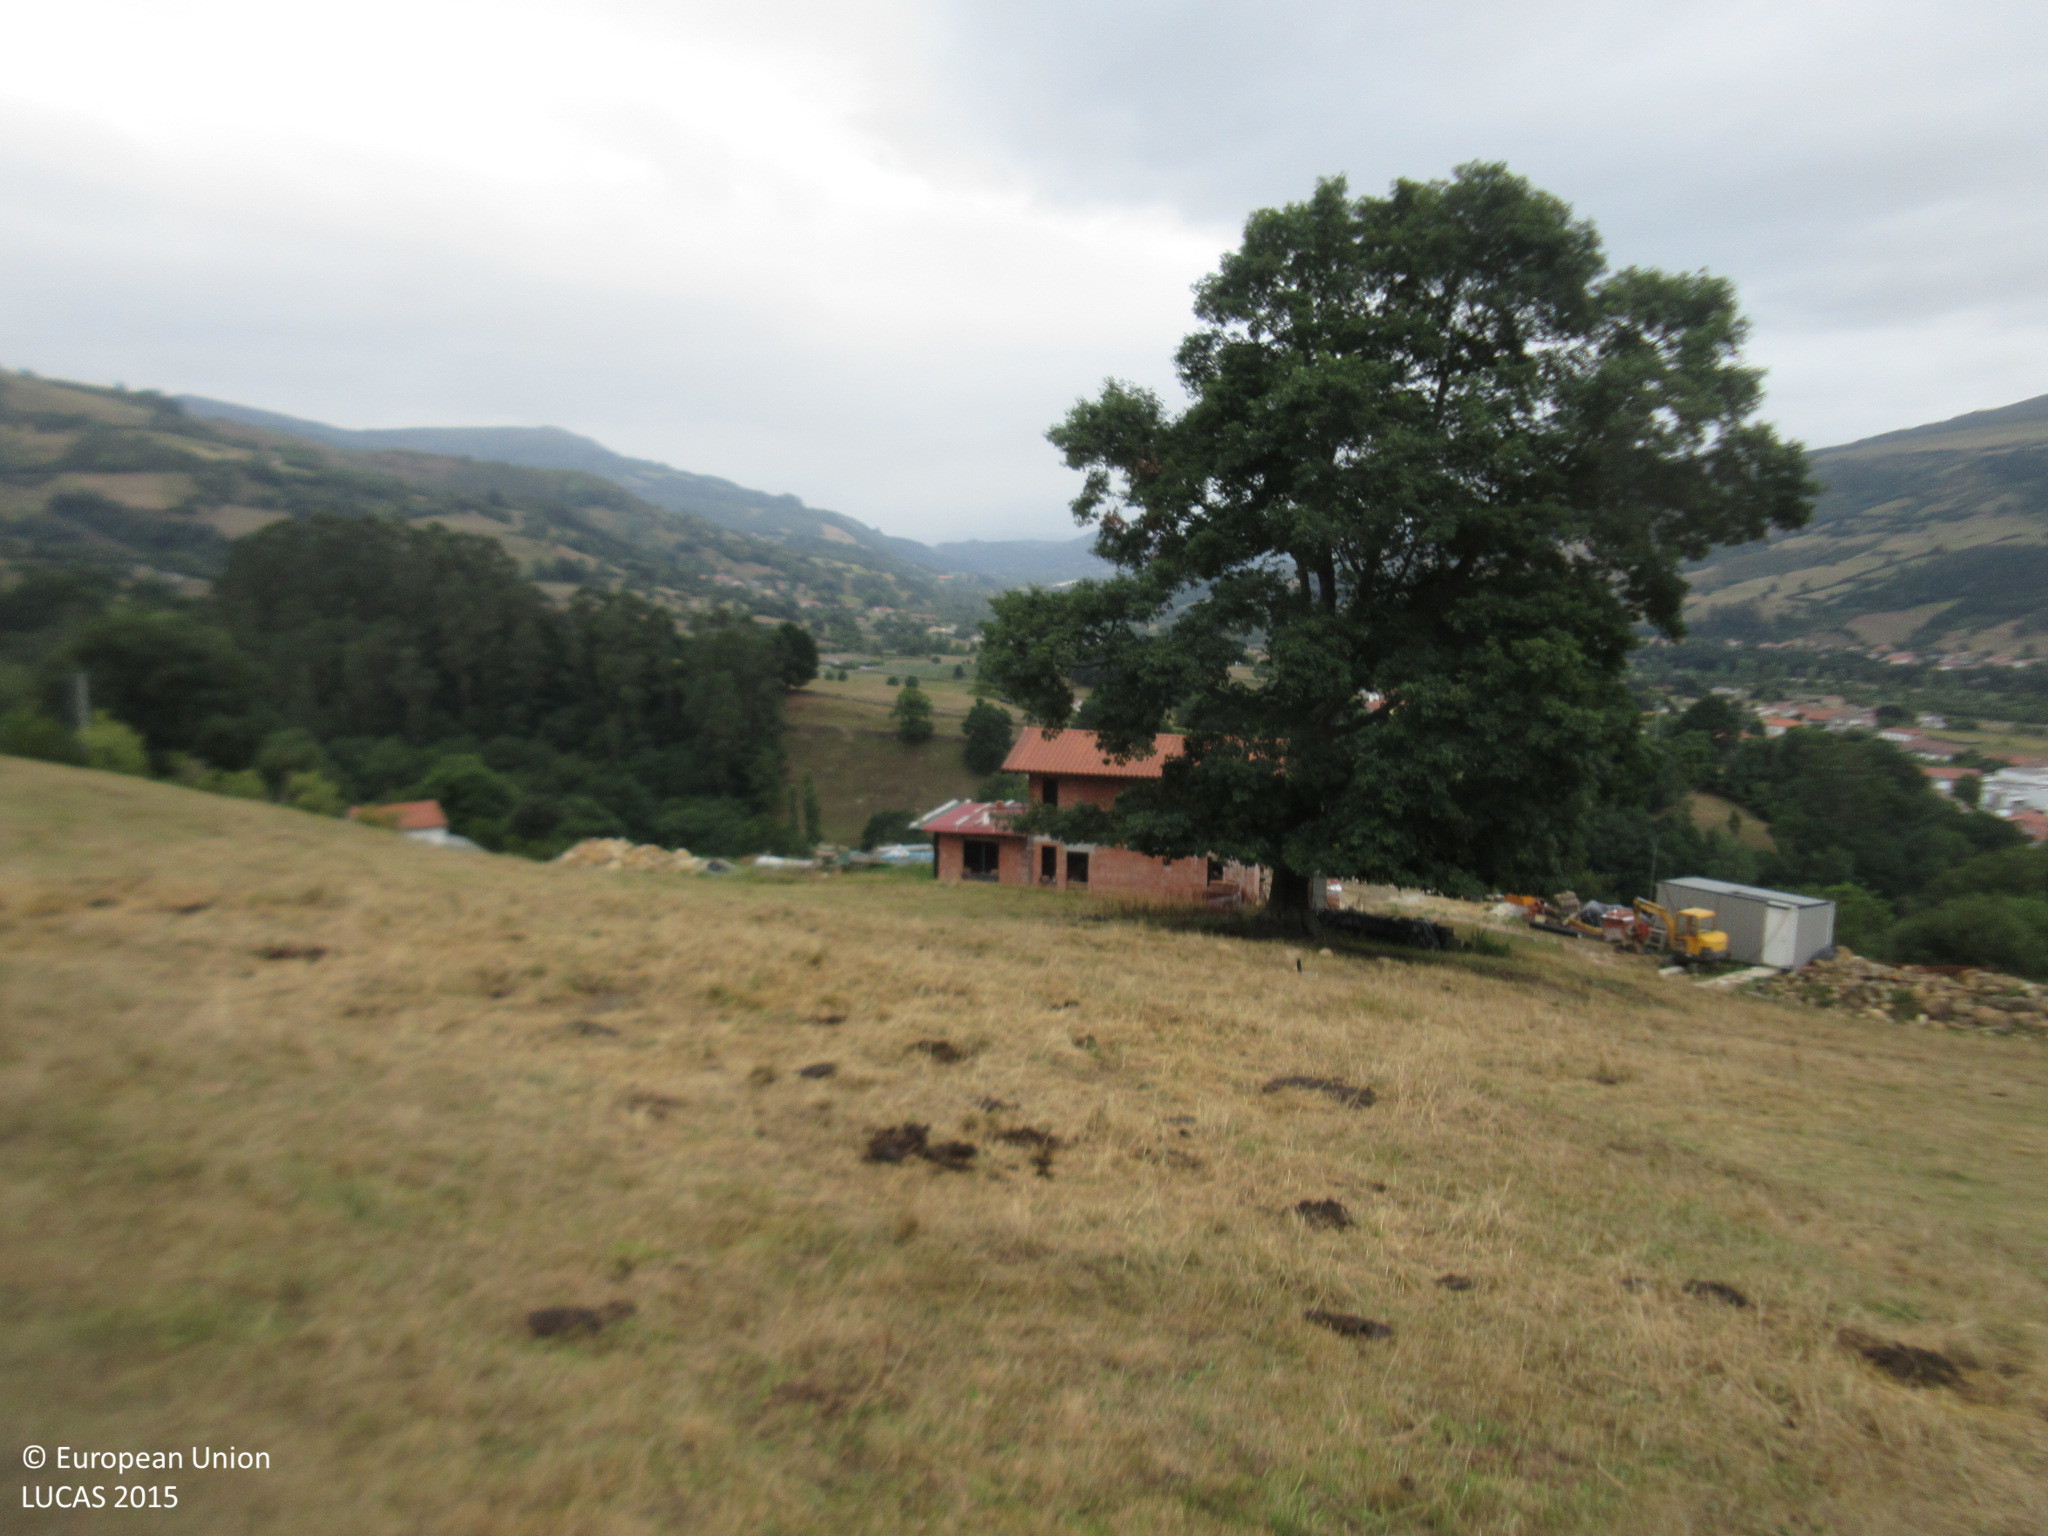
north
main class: Grassland
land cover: Grassland without tree/shrub cover
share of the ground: > 75 %
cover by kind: herbaceous plants 100 %
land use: Agriculture (excluding fallow land and kitchen gardens)
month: July
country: ES
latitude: 43.2026
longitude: -3.9438
